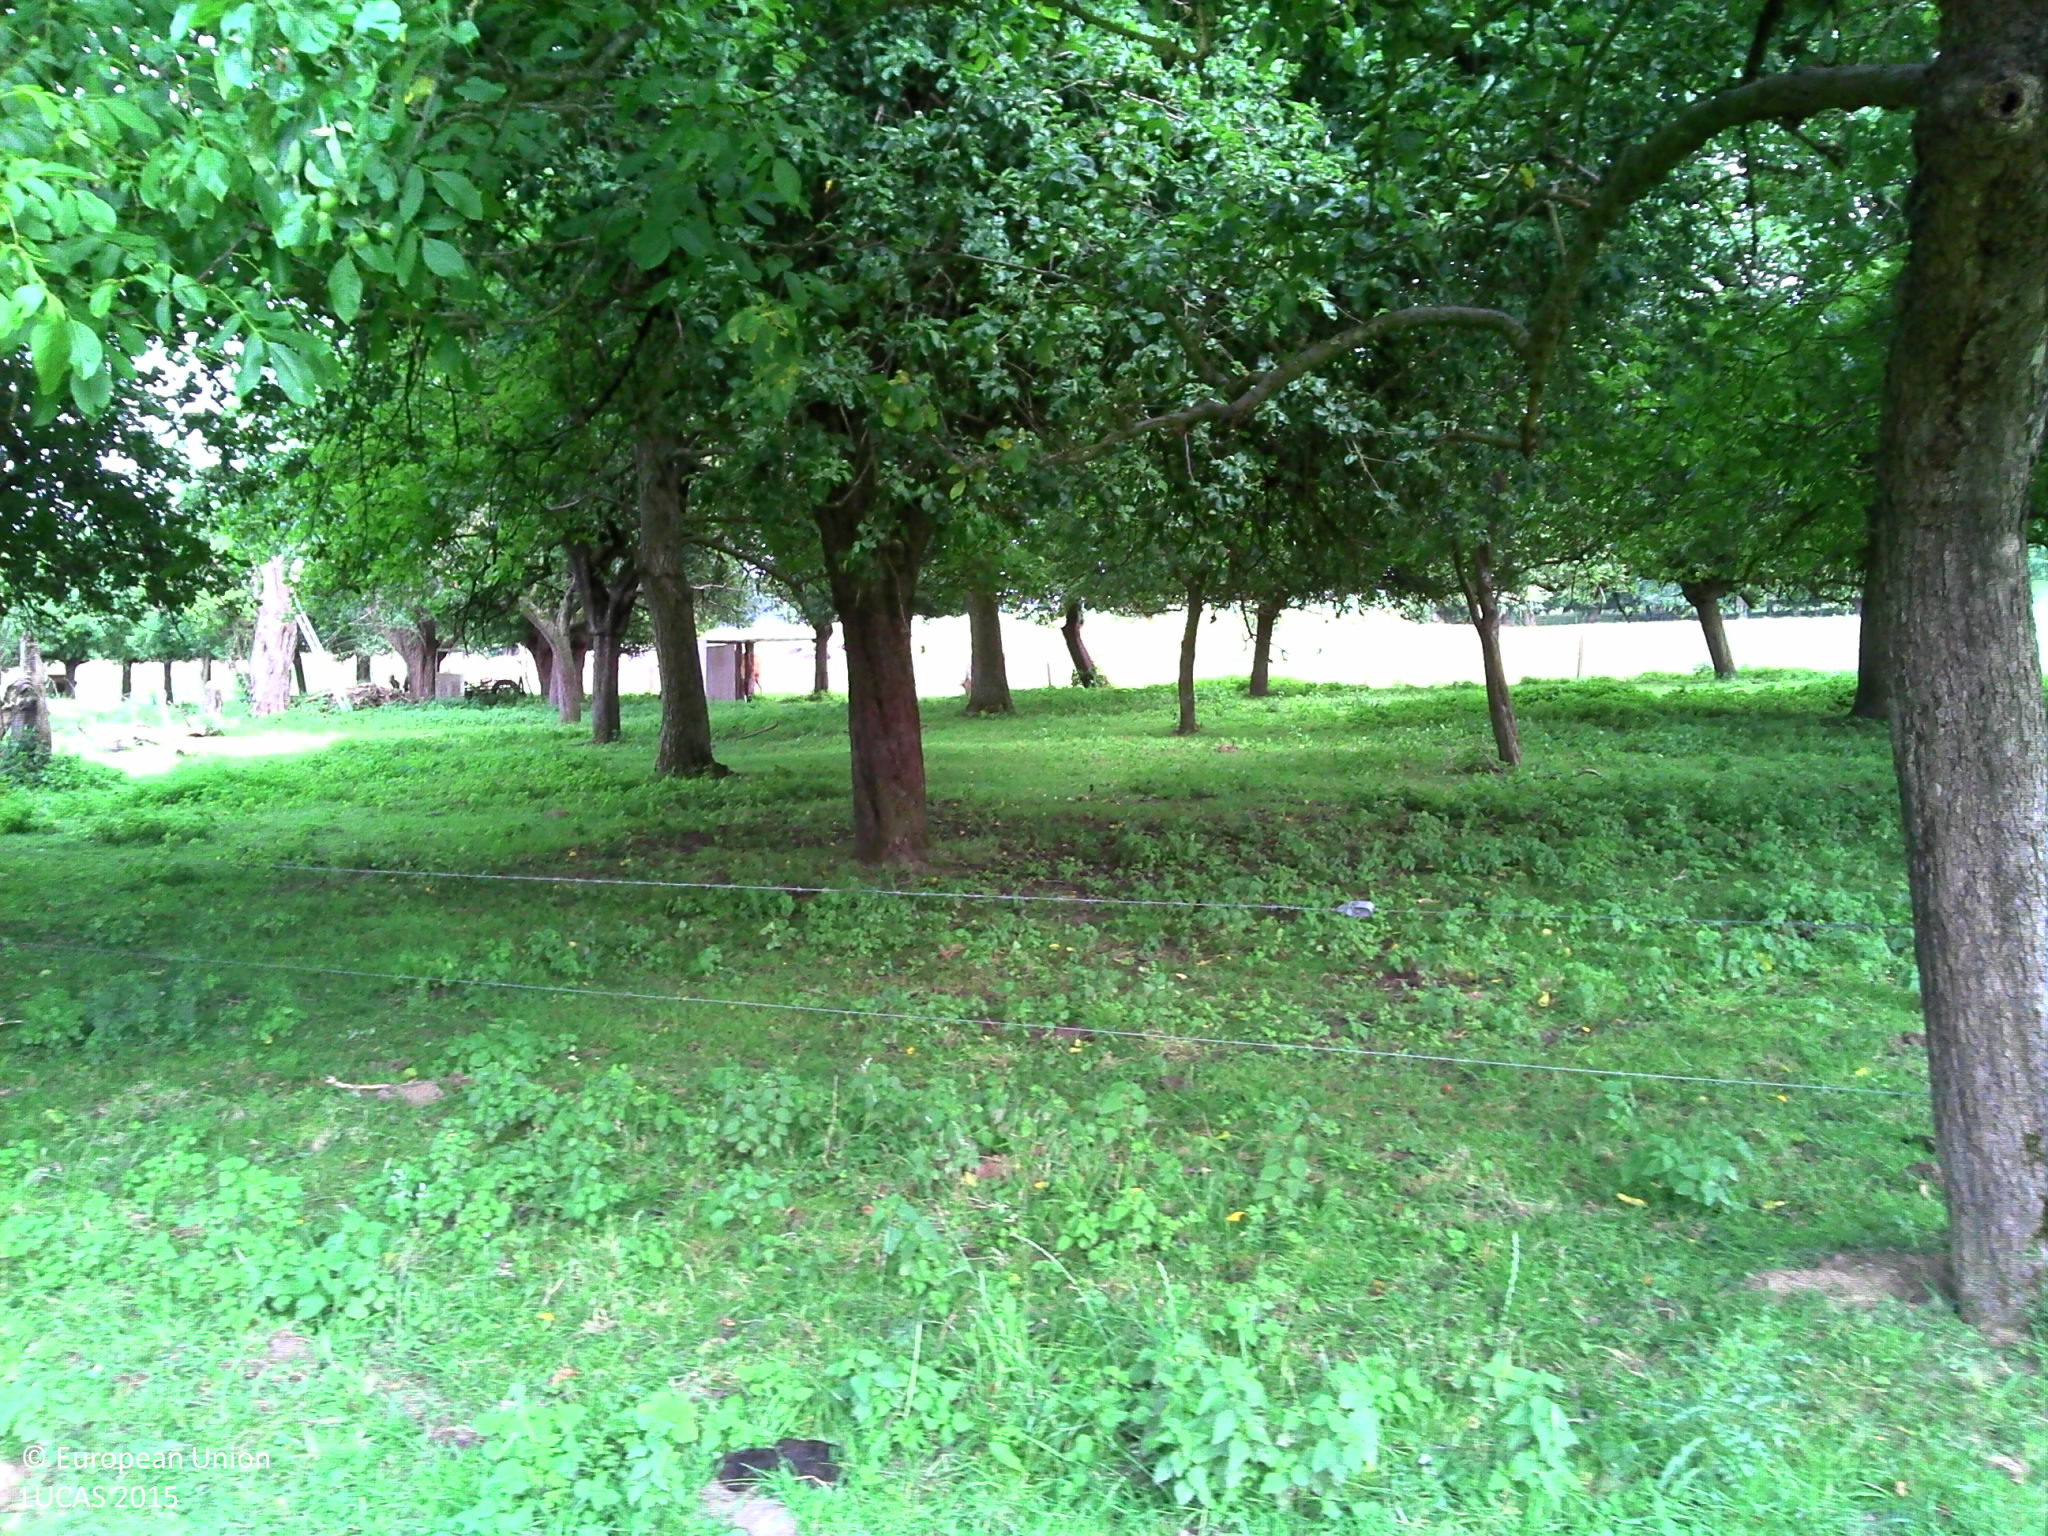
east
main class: Cropland
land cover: Apple fruit
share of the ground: > 75 %
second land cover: Grassland without tree/shrub cover
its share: 50 - 75 %
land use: Agriculture (excluding fallow land and kitchen gardens)
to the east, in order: Apple fruit; Grassland without tree/shrub cover; Fences; Grassland without tree/shrub cover; Other bare soil; Fences; Grassland without tree/shrub cover; Fences; Ditches and canals; Fences; Grassland without tree/shrub cover
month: June
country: BE
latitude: 50.5845
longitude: 3.6514
